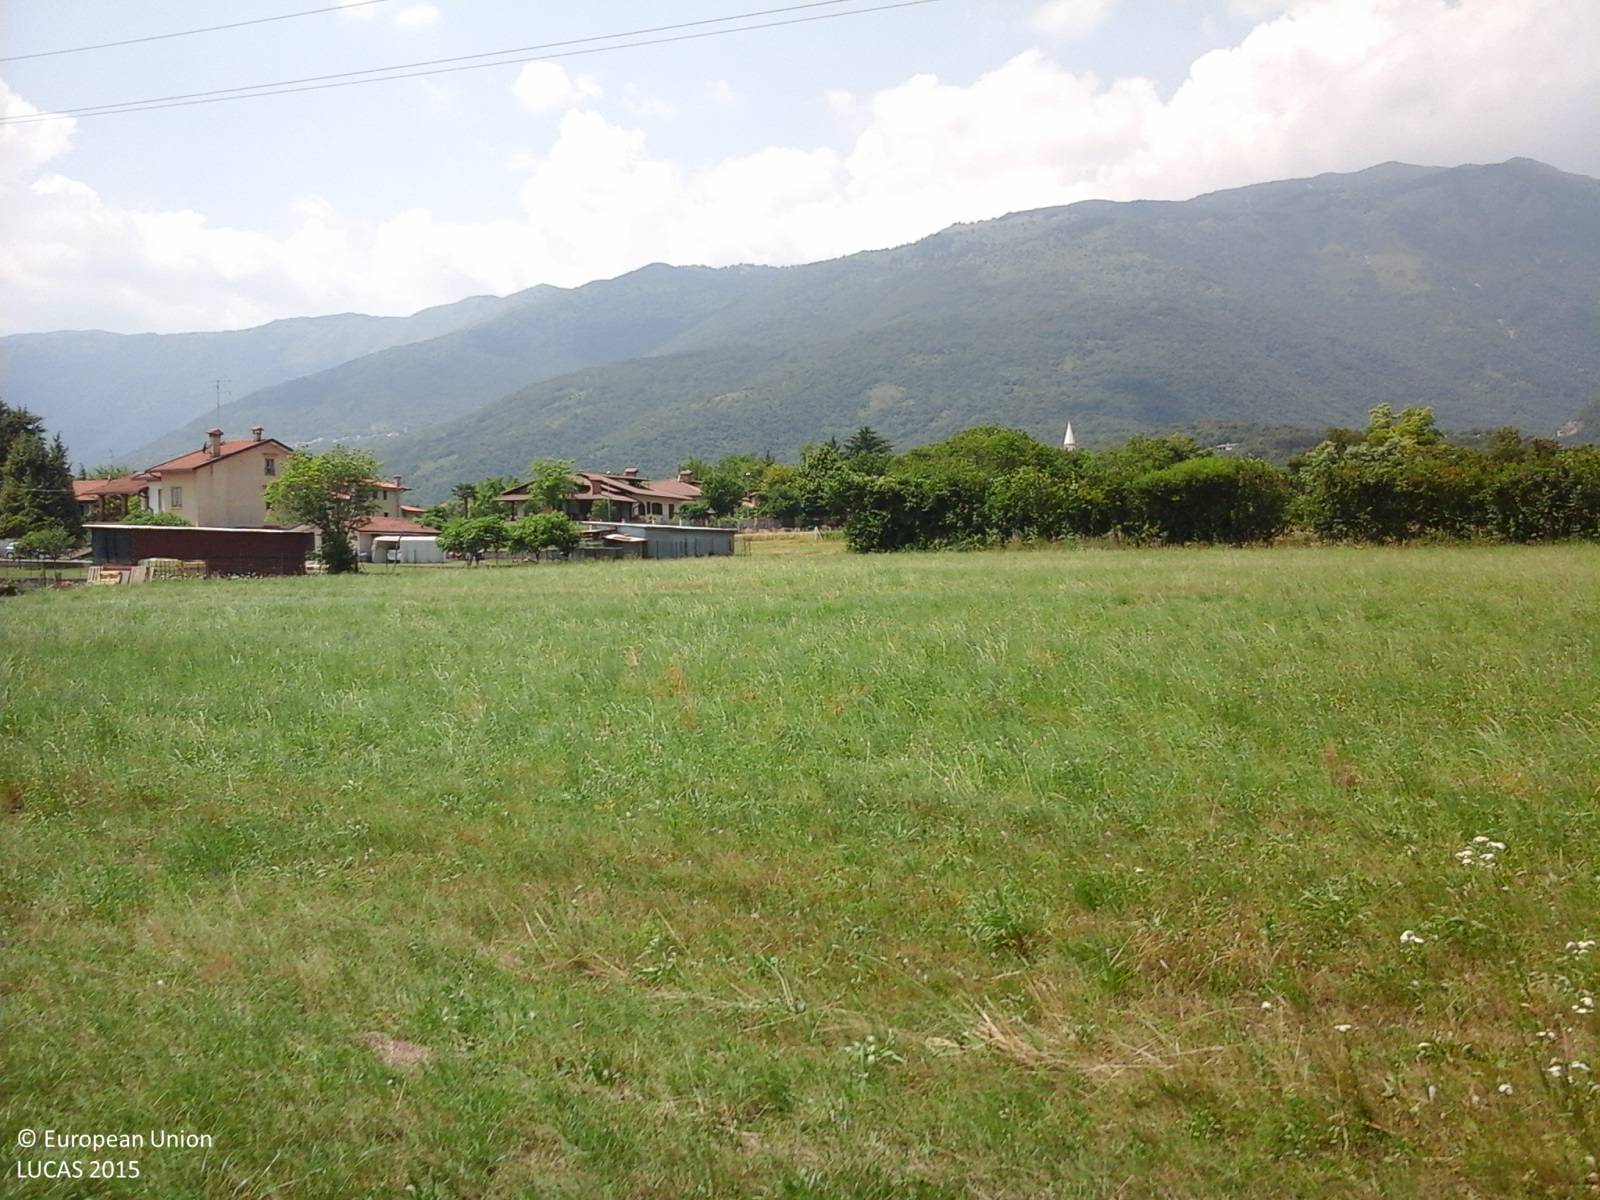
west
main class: Cropland
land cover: Vineyards
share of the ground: > 75 %
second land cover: Grassland without tree/shrub cover
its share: > 75 %
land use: Agriculture (excluding fallow land and kitchen gardens)
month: June
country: IT
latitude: 46.0507
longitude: 12.5429
